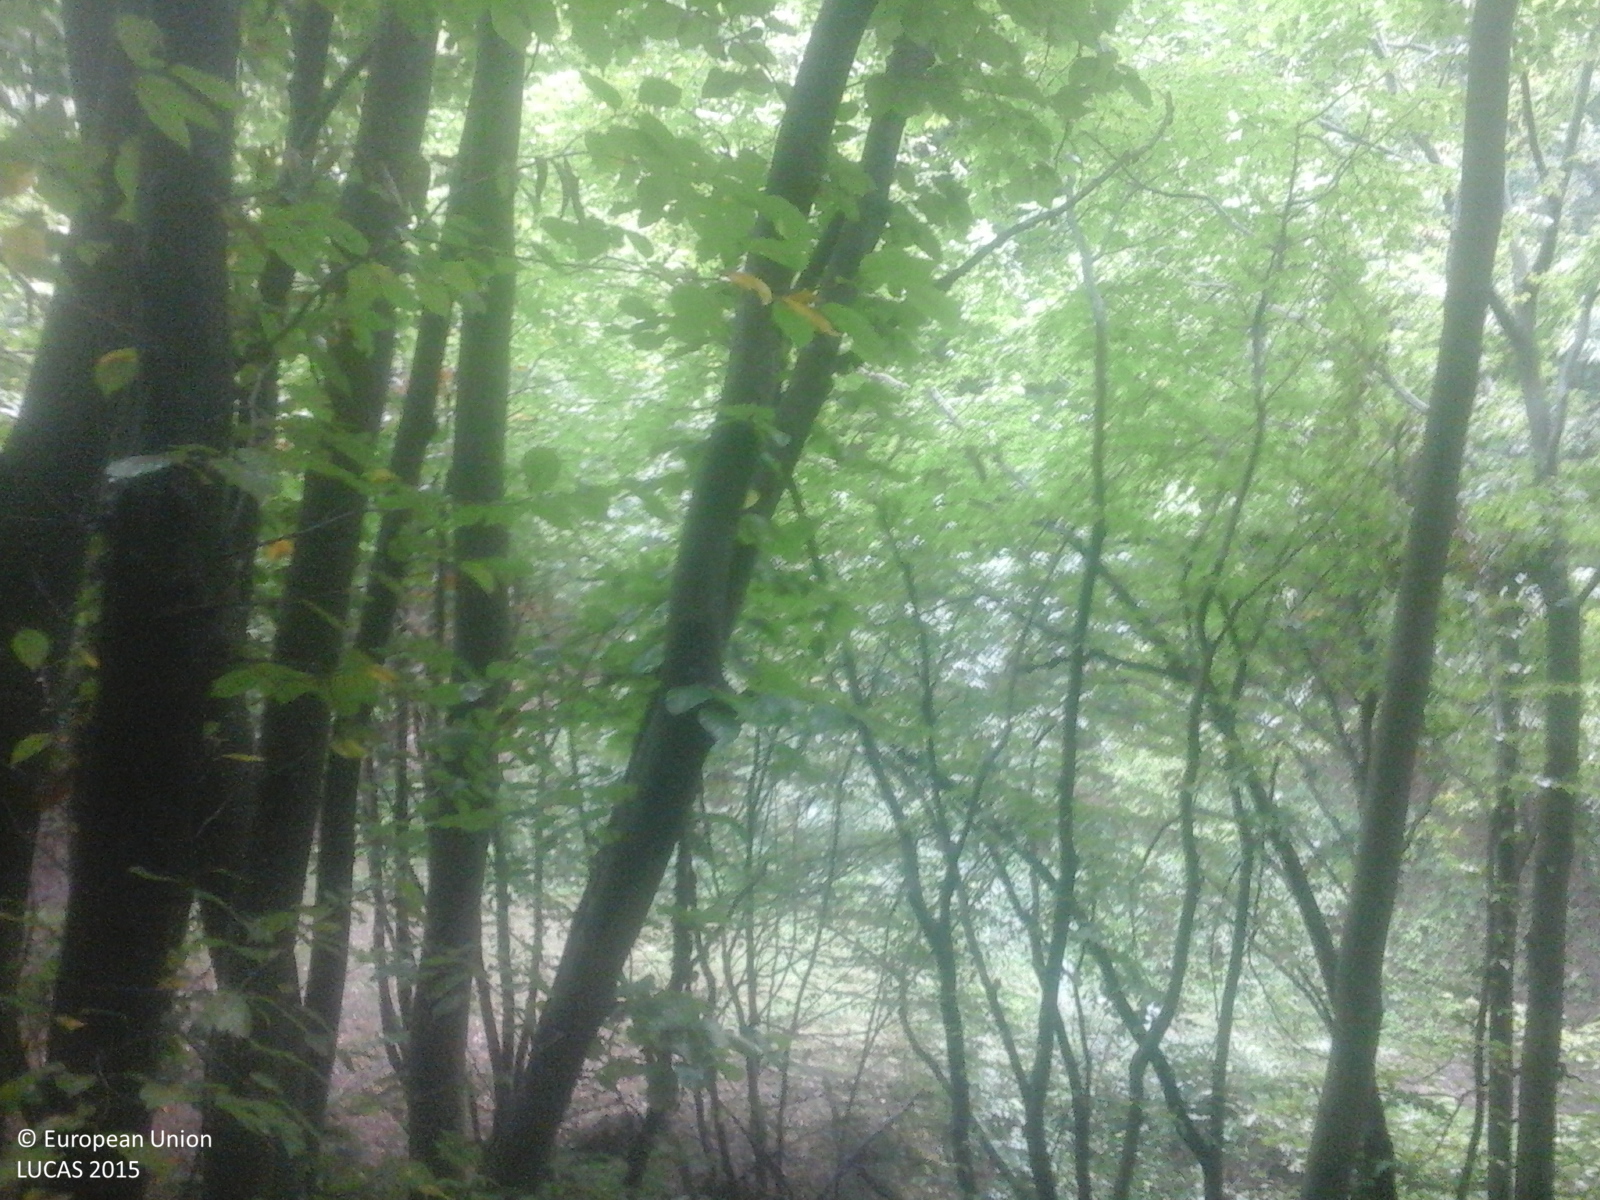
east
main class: Woodland
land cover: Broadleaved woodland
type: beech forest
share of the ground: > 75 %
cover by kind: broadleaved forest trees 100 %
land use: Forestry
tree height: > 5 m
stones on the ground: 10 - 25 %
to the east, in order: Broadleaved woodland; Rivers and streams; Broadleaved woodland
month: September
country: RO
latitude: 45.8299
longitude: 23.6994
